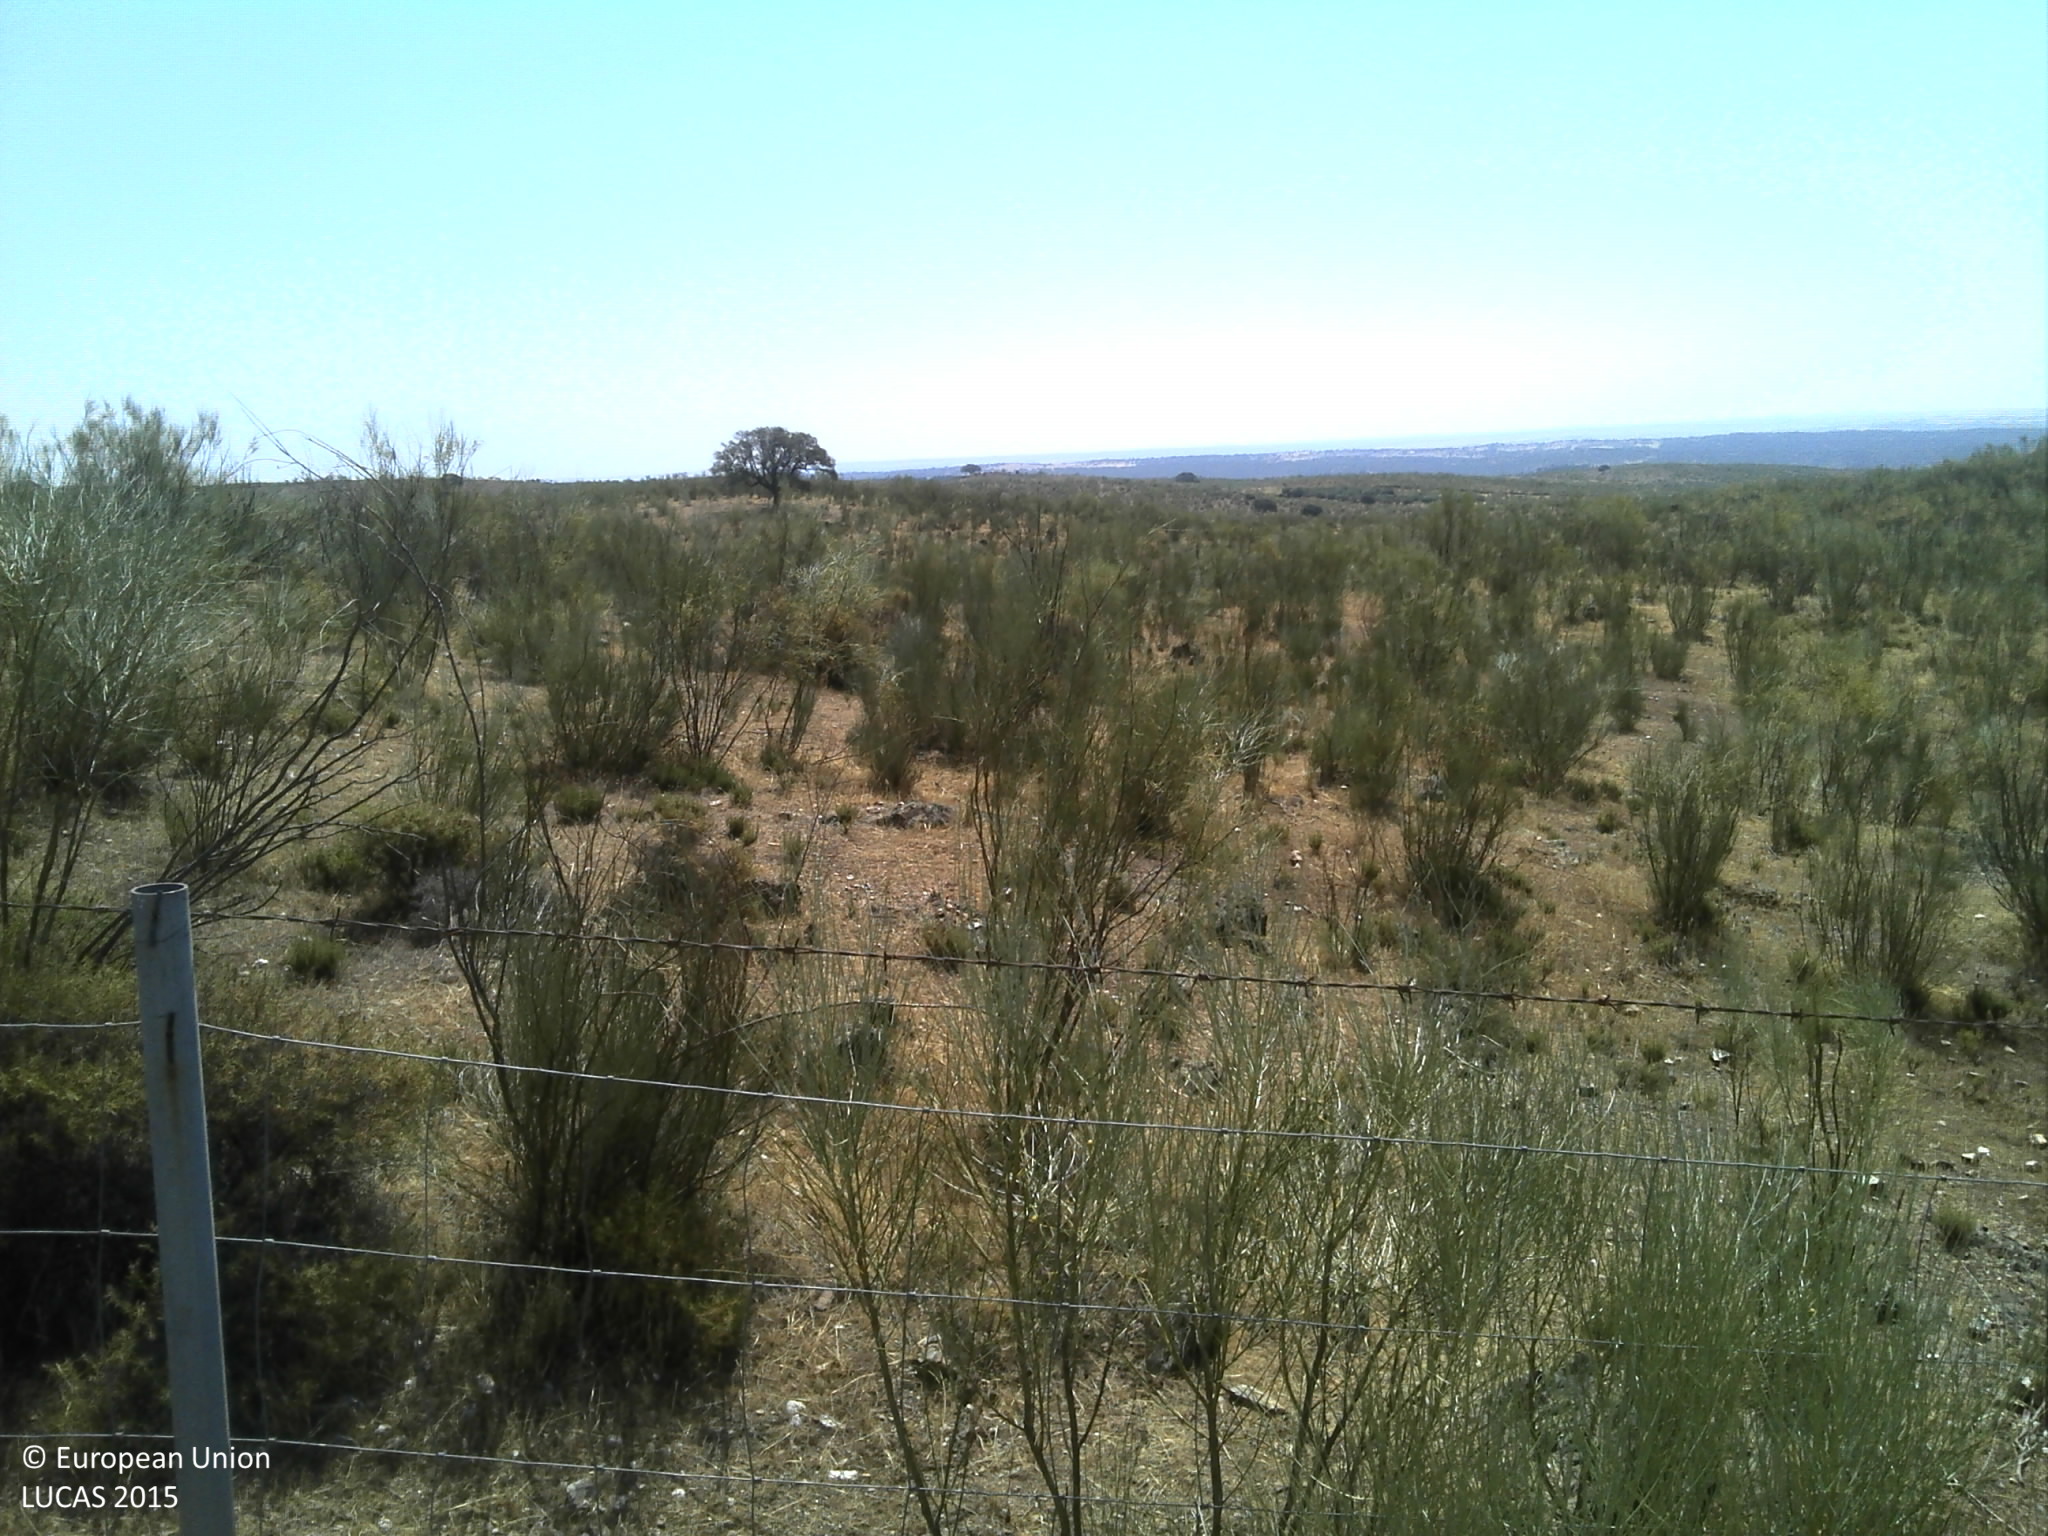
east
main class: Shrubland
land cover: Shrubland with sparse tree cover
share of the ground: 50 - 75 %
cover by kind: shrubs 65 %, herbaceous plants 30 %, broadleaved forest trees 5 %
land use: Abandoned areas
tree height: < 5 m
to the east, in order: Shrubland with sparse tree cover; Olive groves; Dry stone walls; Shrubland with sparse tree cover; Tracks; Shrubland with sparse tree cover
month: June
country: PT
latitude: 39.7236
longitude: -7.0378
